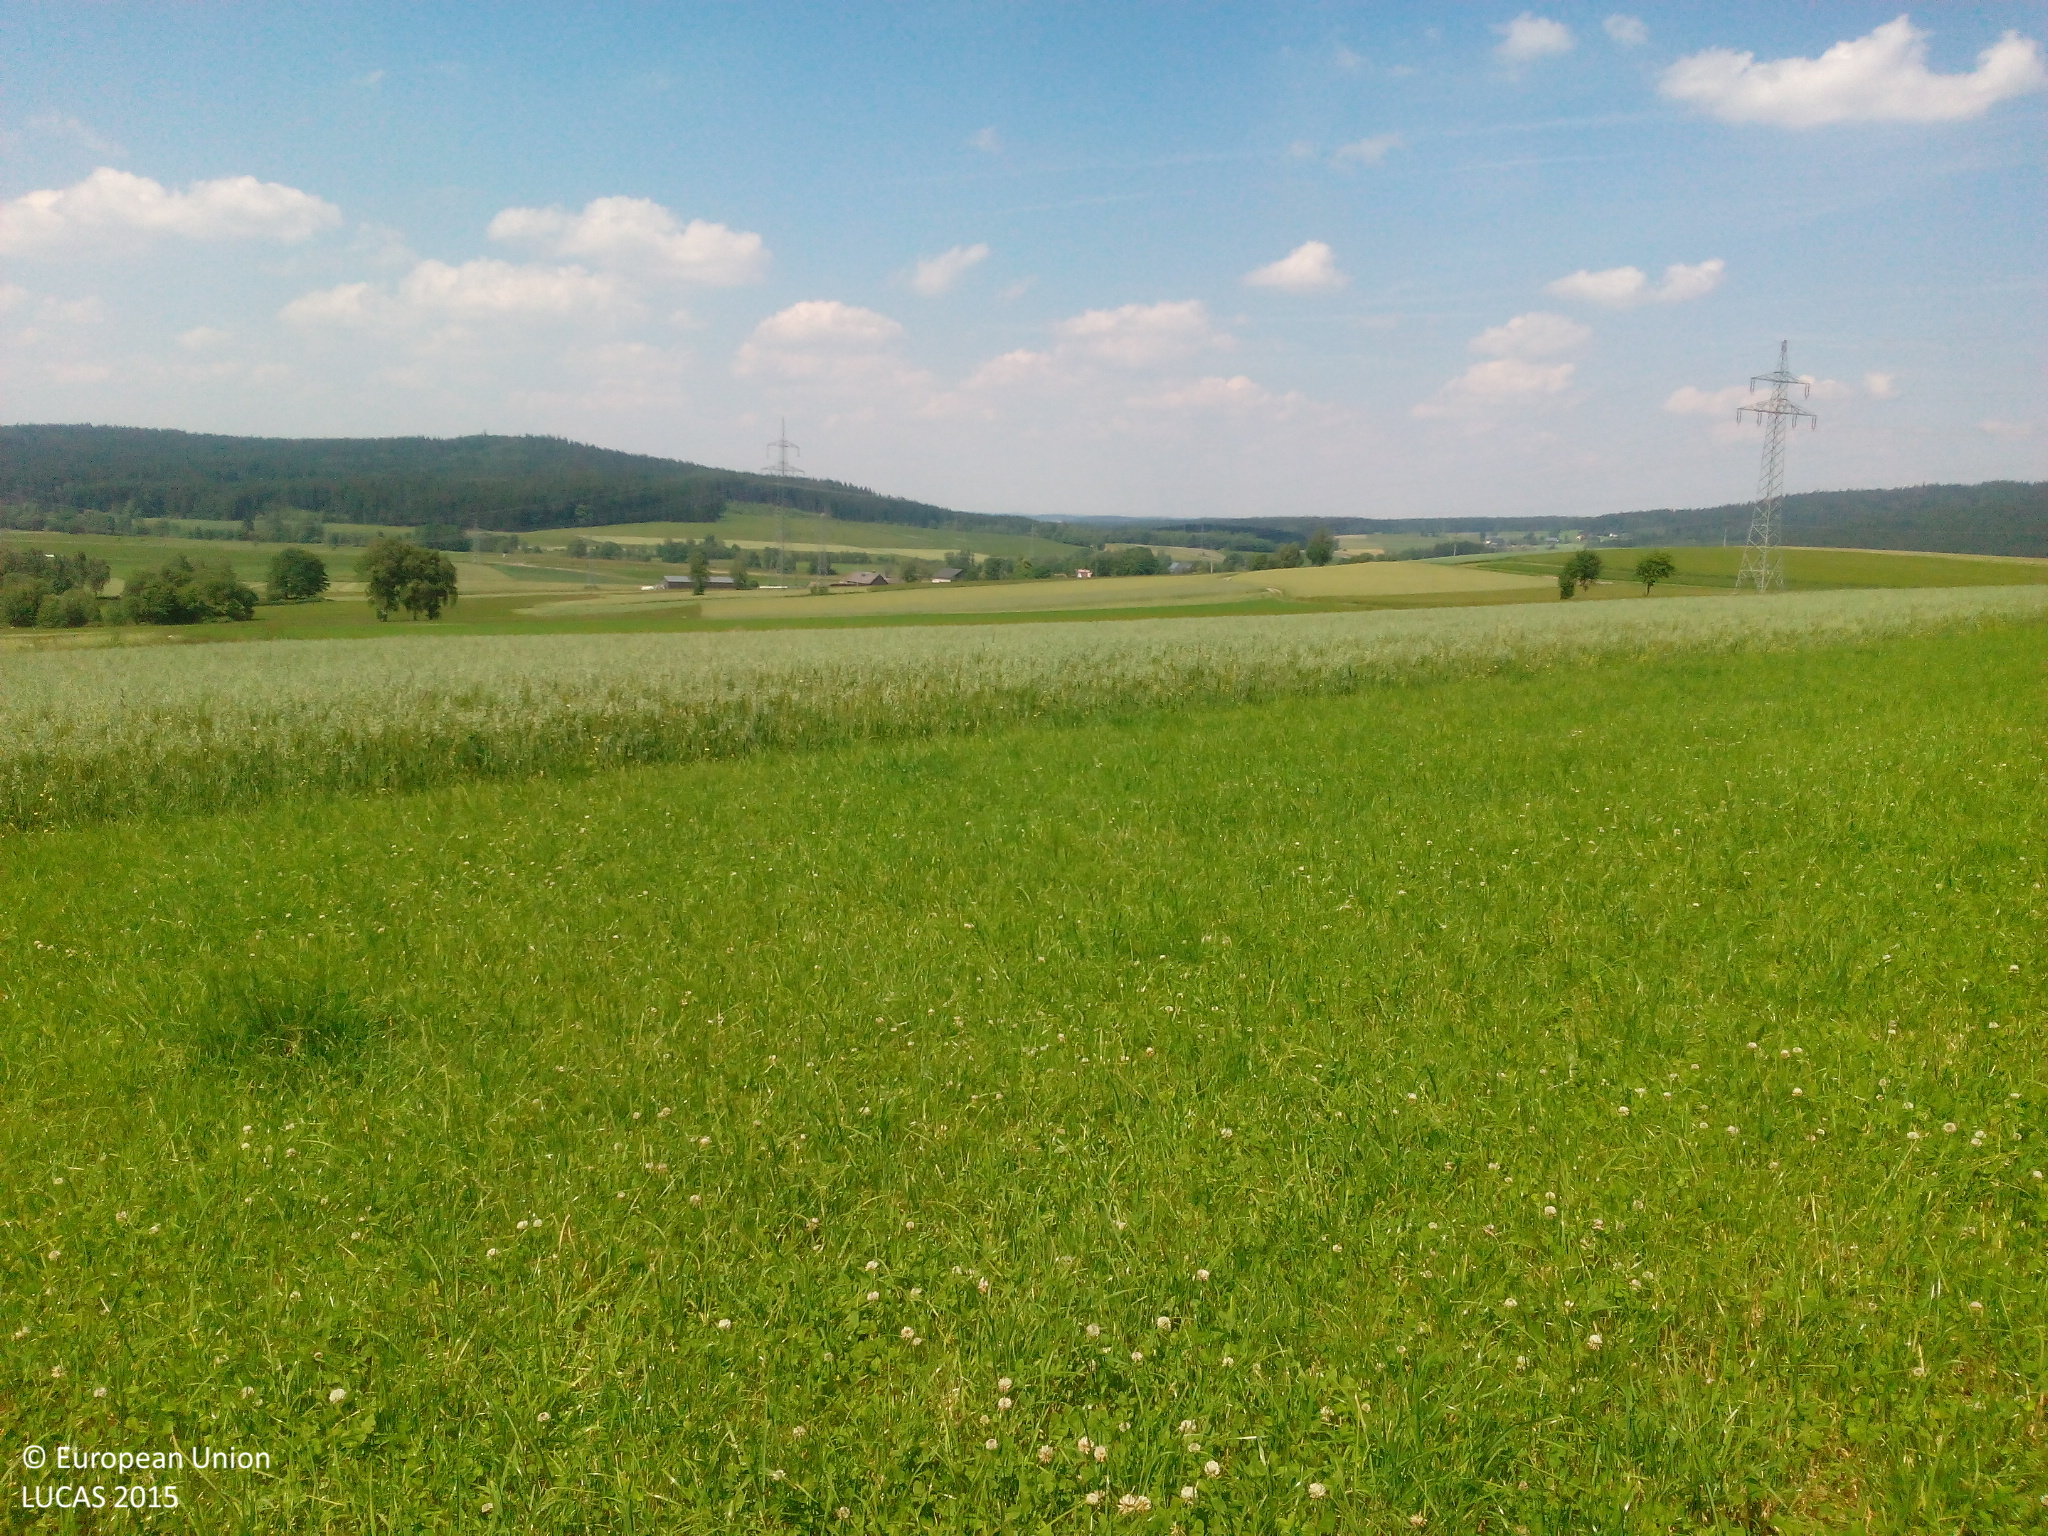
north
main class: Grassland
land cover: Grassland without tree/shrub cover
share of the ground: > 75 %
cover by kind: herbaceous plants 90 %, unconsolidated bare surface 10 %
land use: Agriculture (excluding fallow land and kitchen gardens)
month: June
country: DE
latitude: 50.1492
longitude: 11.9728
